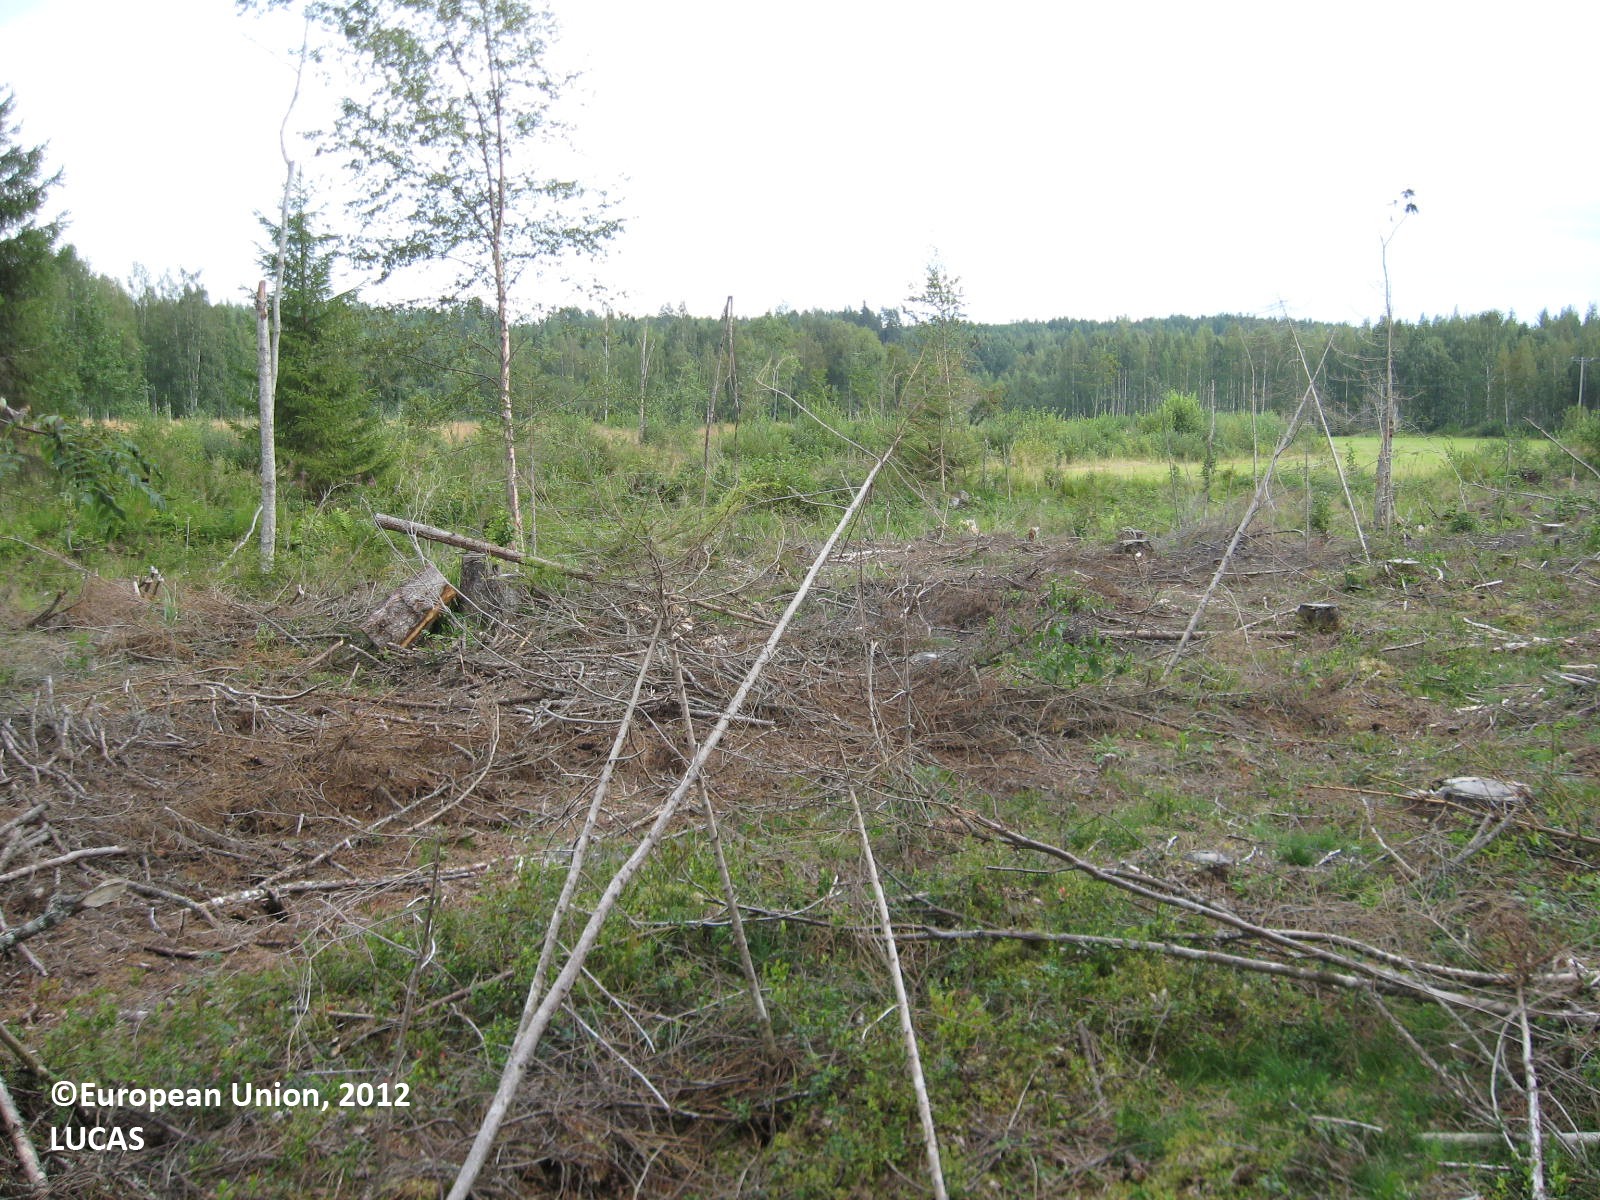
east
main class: Grassland
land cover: Grassland with sparse tree/shrub cover
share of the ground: 50 - 75 %
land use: Forestry
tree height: < 5 m
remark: Clear cut
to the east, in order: Grassland with sparse tree/shrub cover; Ditches and canals; Temporary grasslands; Ditches and canals; Shruby margins; Shrubland with sparse tree cover; Ditches and canals; Temporary grasslands; Ditches and canals; Temporary grasslands
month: August
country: FI
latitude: 63.3380
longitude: 29.6301
